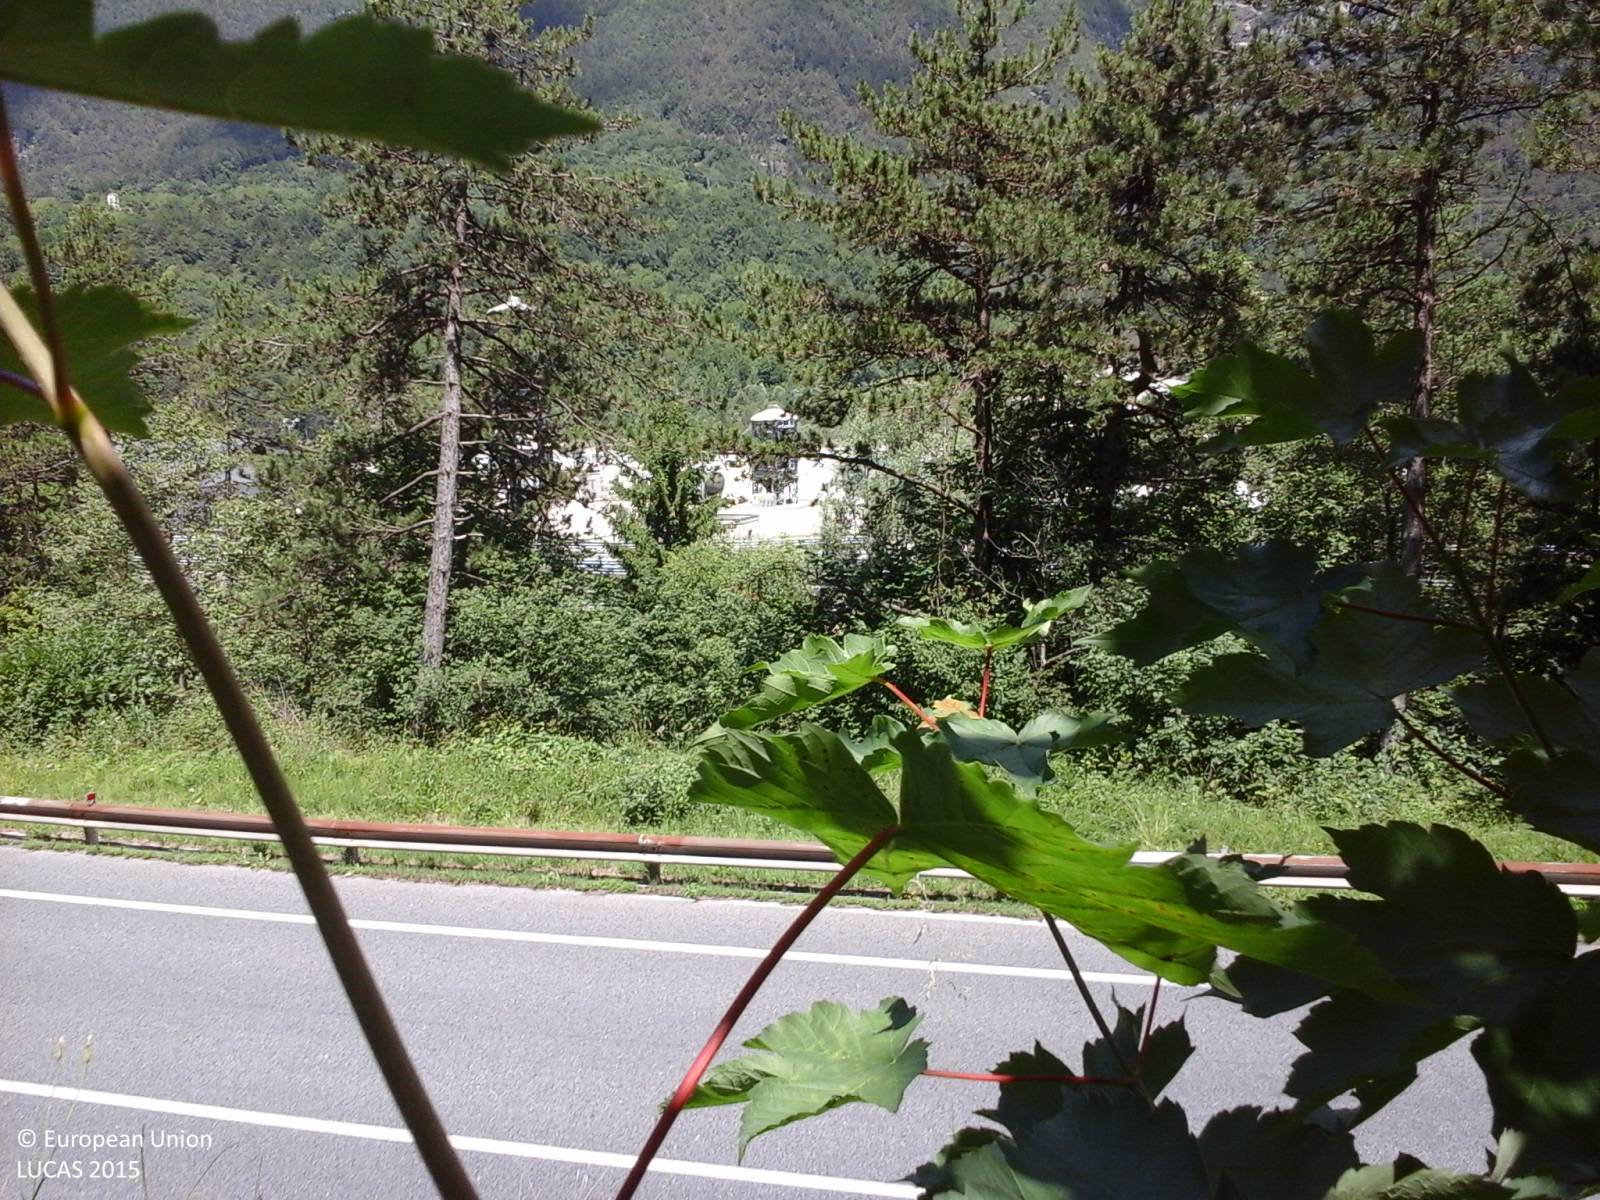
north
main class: Woodland
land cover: Pine dominated coniferous woodland
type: alpine coniferous forest
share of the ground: > 75 %
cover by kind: coniferous forest trees 70 %, broadleaved forest trees 10 %, shrubs 10 %, herbaceous plants 10 %
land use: Semi-natural and natural areas not in use
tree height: > 5 m
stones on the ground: 25 - 50 %
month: June
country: IT
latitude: 46.3924
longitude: 13.2350
